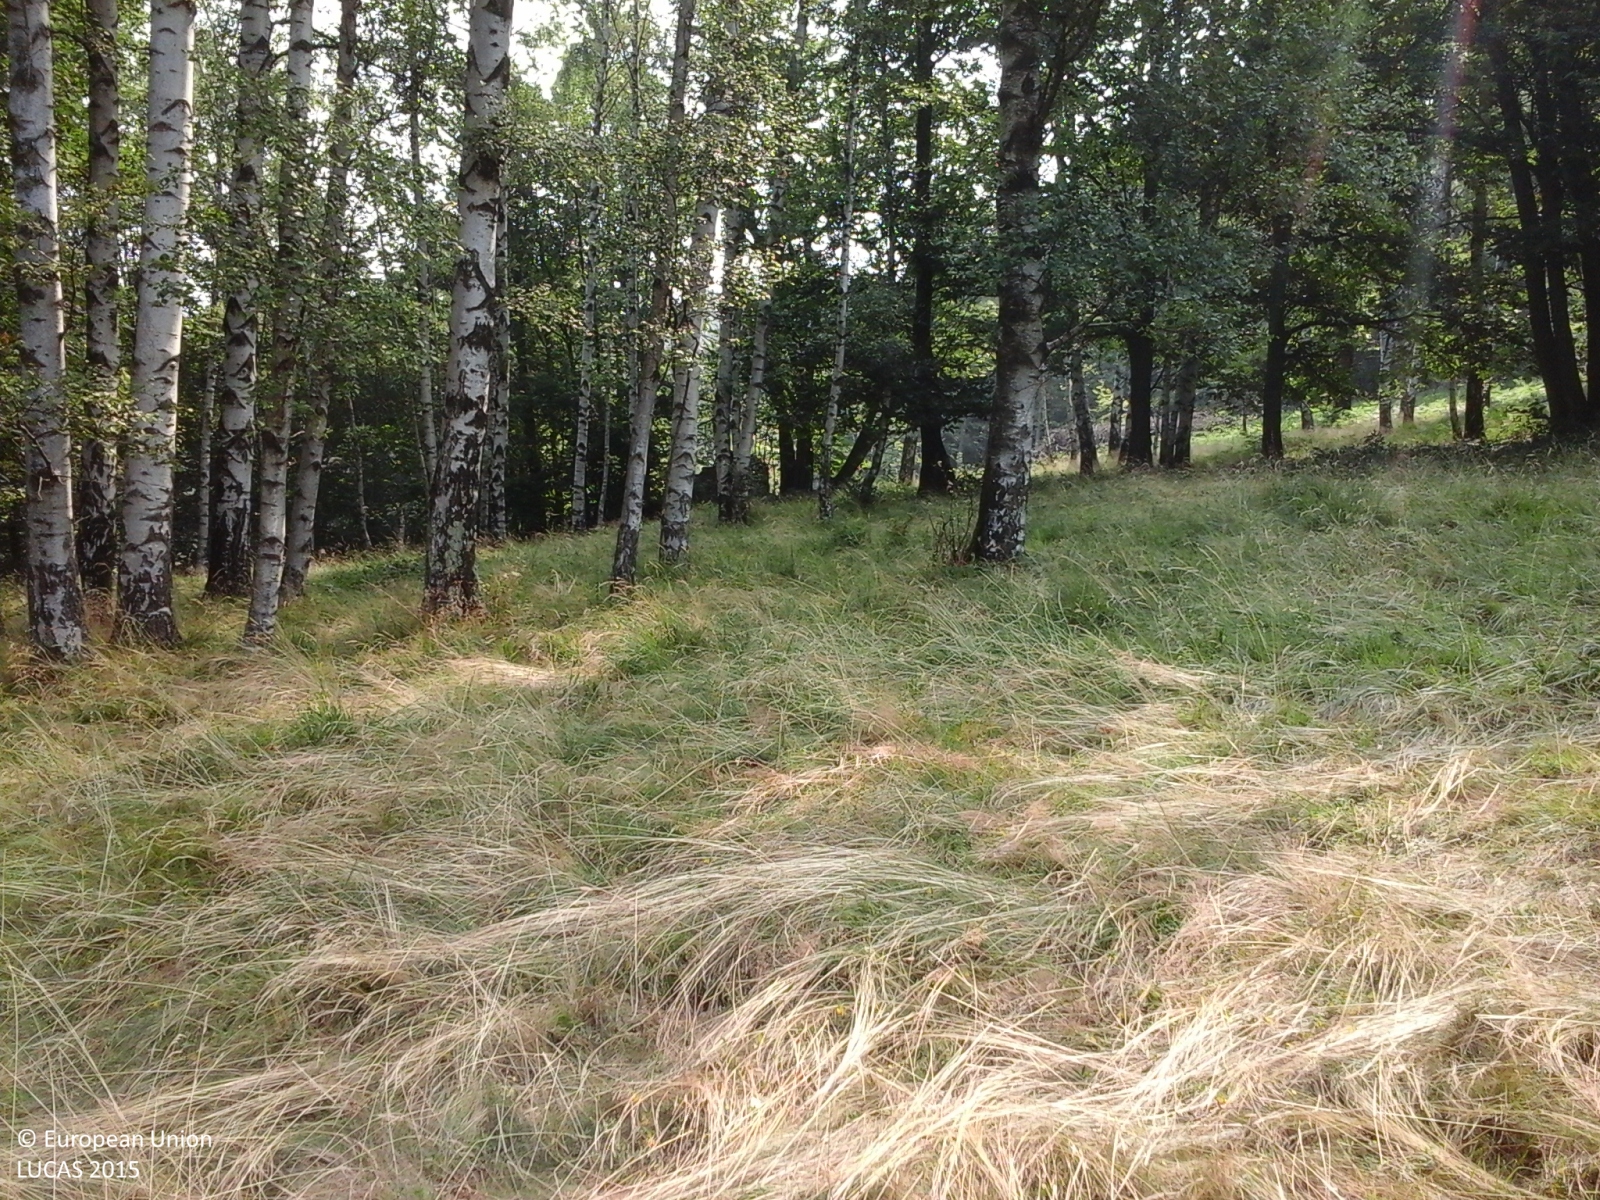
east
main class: Grassland
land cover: Grassland without tree/shrub cover
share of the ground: > 75 %
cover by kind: herbaceous plants 100 %
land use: Agriculture (excluding fallow land and kitchen gardens)
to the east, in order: Grassland without tree/shrub cover; Broadleaved woodland; Dry stone walls; Broadleaved woodland; Paved roads, cycling and walking lanes; Broadleaved woodland
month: July
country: IT
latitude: 45.4813
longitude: 7.7902
